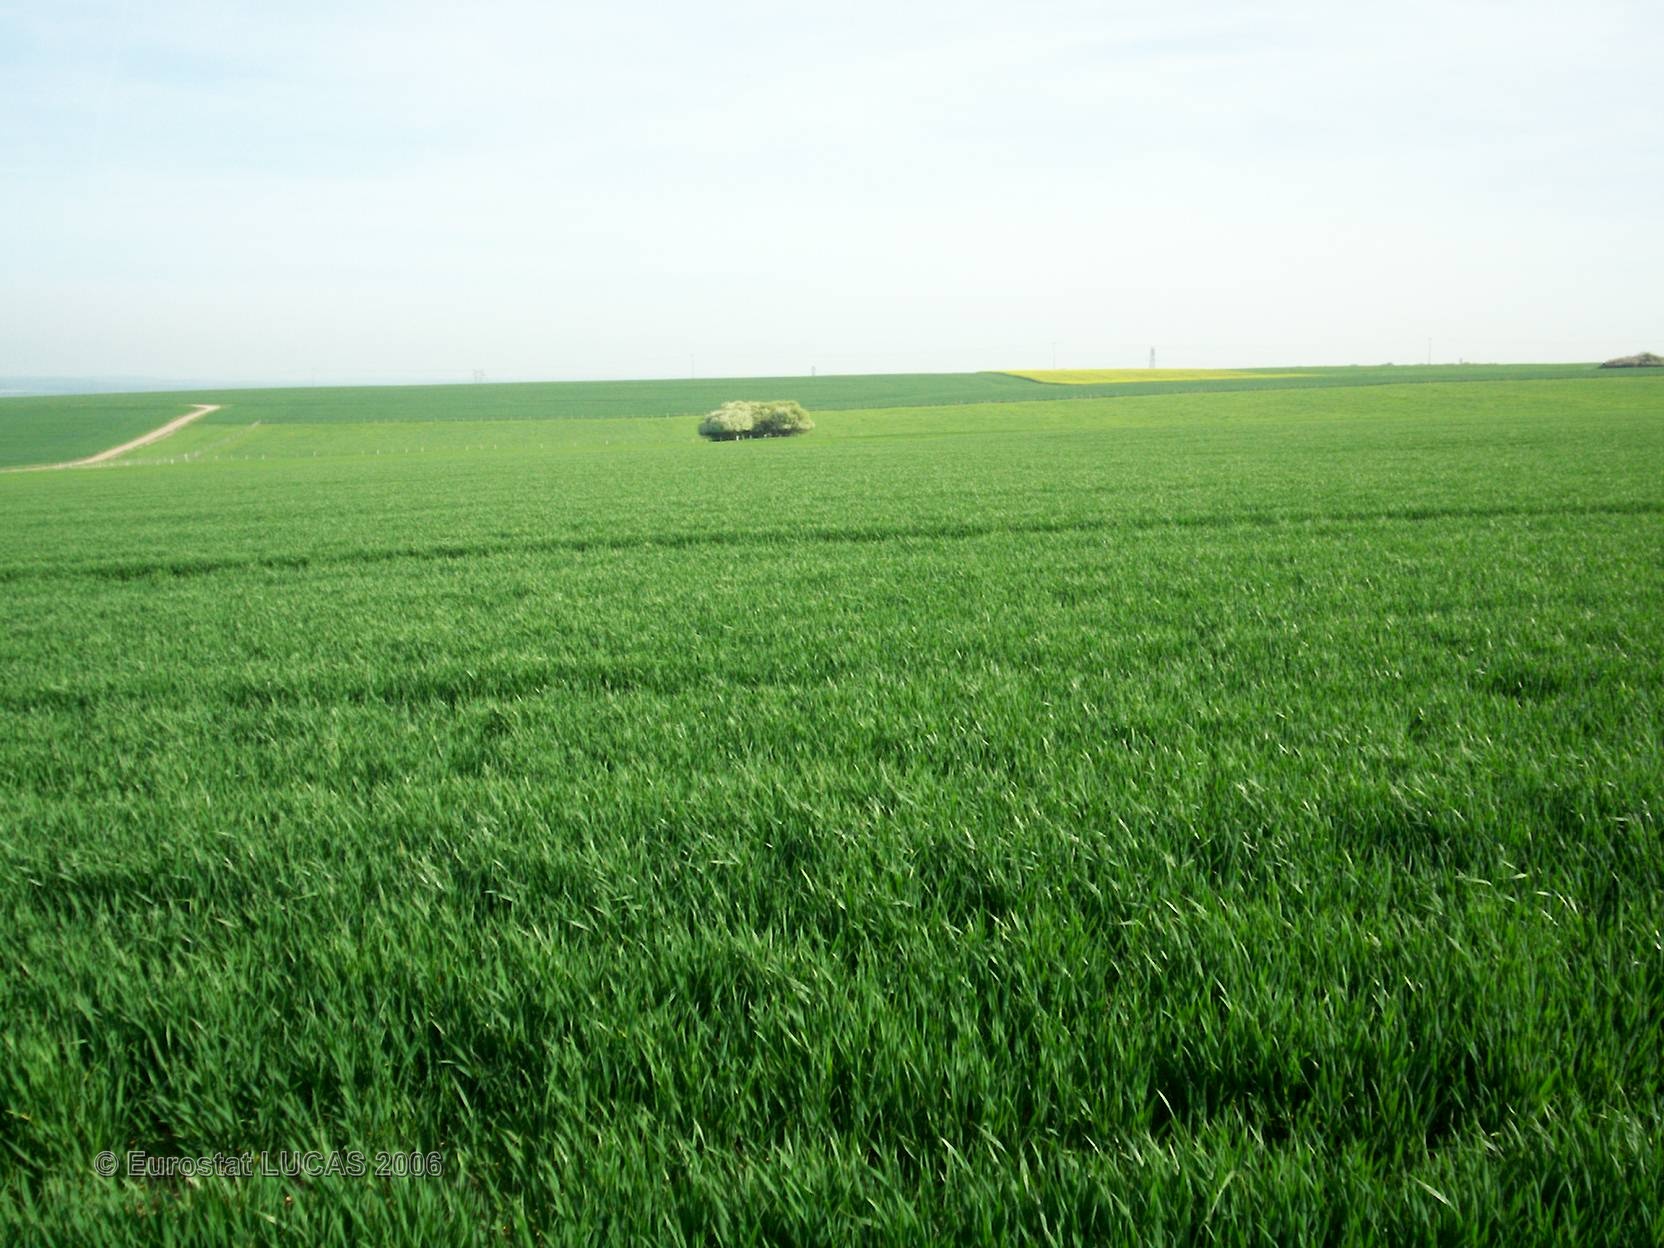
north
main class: Cropland
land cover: Common wheat
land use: Agriculture (excluding fallow land and kitchen gardens)
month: May
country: FR
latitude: 49.1406
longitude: 6.5046
